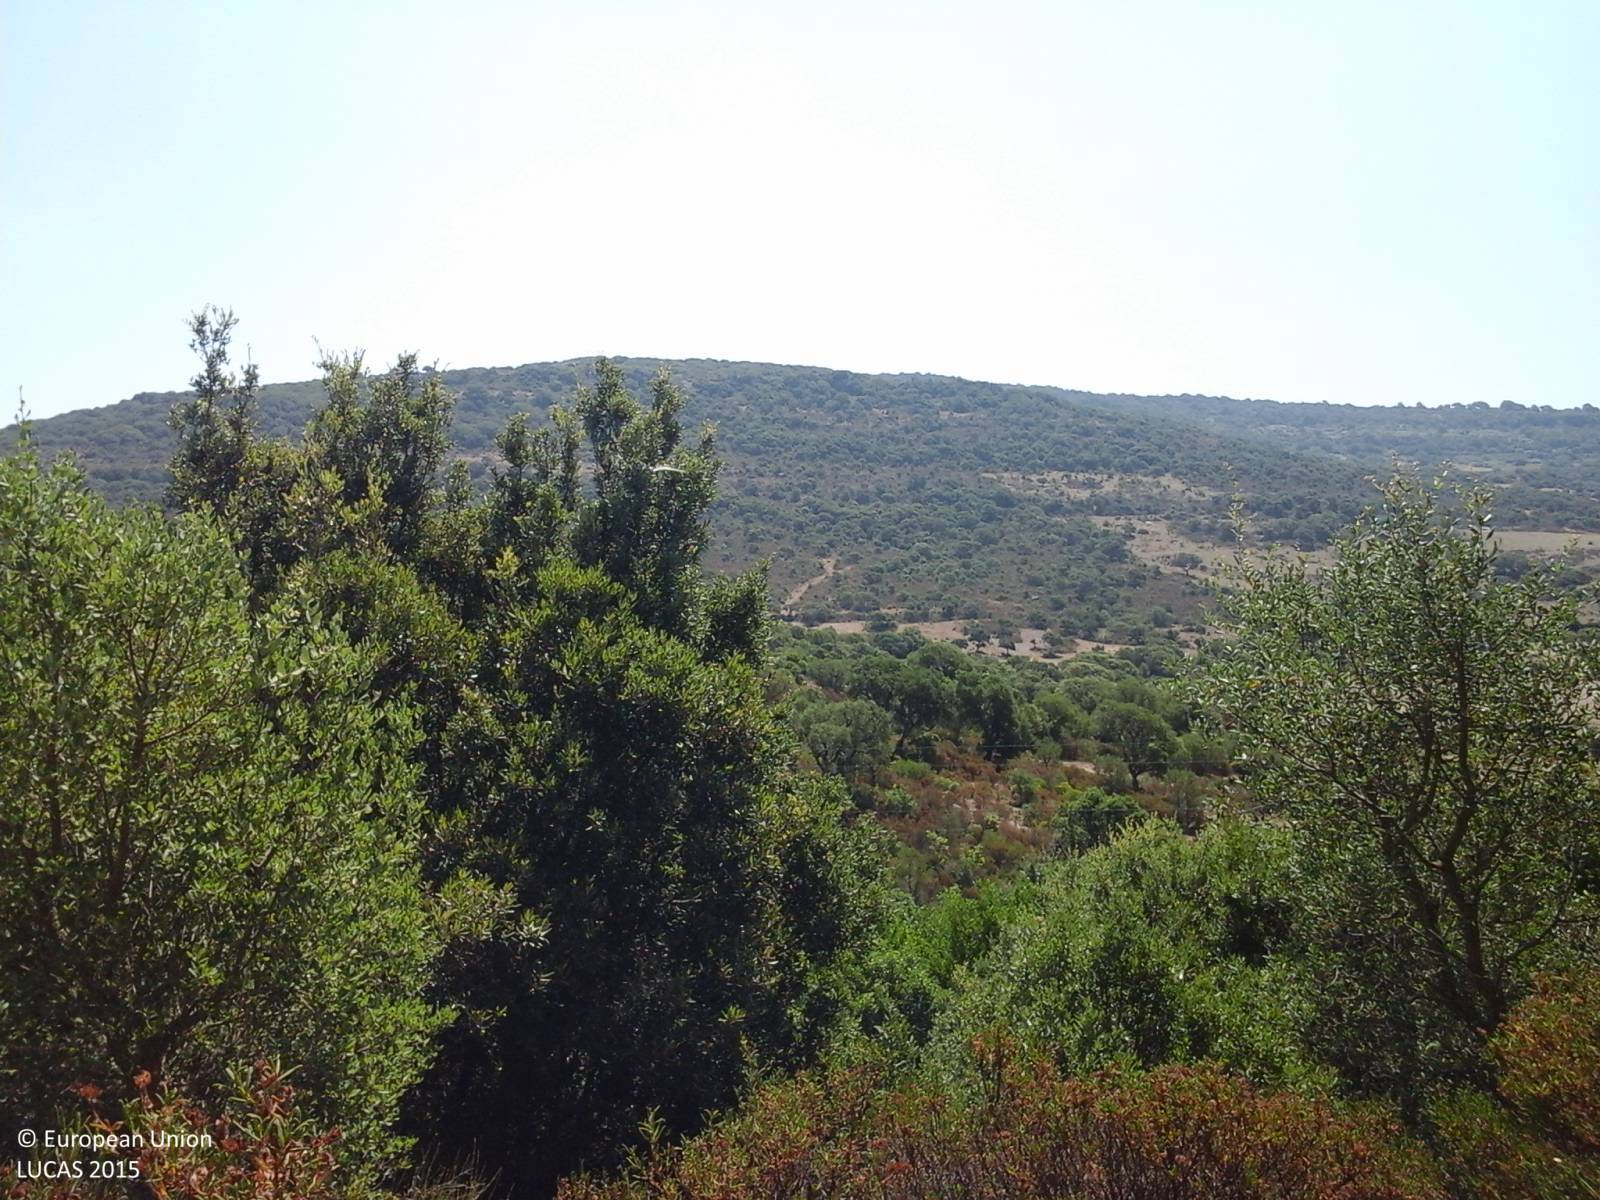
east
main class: Shrubland
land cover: Shrubland with sparse tree cover
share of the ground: 25 - 50 %
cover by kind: herbaceous plants 70 %, shrubs 25 %, broadleaved forest trees 5 %
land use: Agriculture (excluding fallow land and kitchen gardens)
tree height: < 5 m
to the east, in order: Shrubland with sparse tree cover; Rivers and streams; Electric lines; Shrubland with sparse tree cover; Grassland with sparse tree/shrub cover; Grassland without tree/shrub cover; Grassland with sparse tree/shrub cover
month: July
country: IT
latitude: 40.5084
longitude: 8.4382
